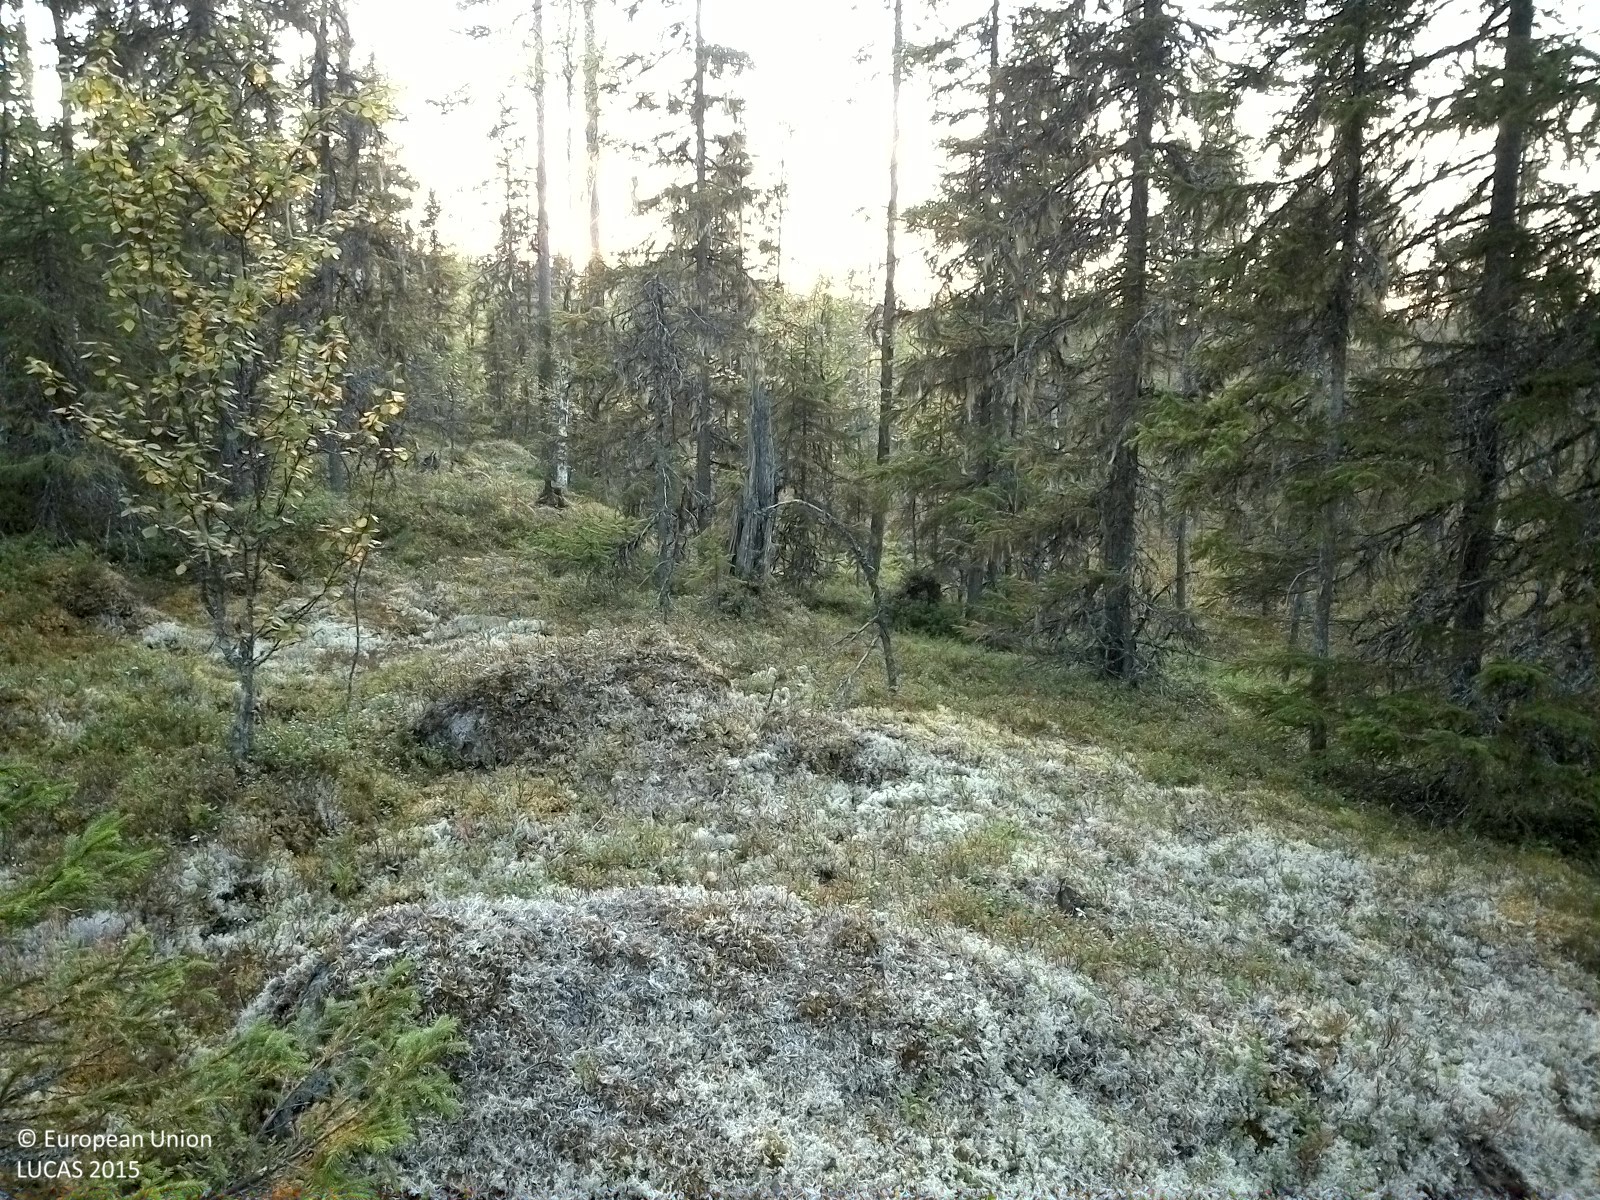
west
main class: Woodland
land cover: Other mixed woodland
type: boreal forest
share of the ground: 50 - 75 %
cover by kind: coniferous forest trees 40 %, lichens and mosses 25 %, shrubs 20 %, broadleaved forest trees 15 %
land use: Forestry
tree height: > 5 m
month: September
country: SE
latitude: 62.6326
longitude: 16.1208
